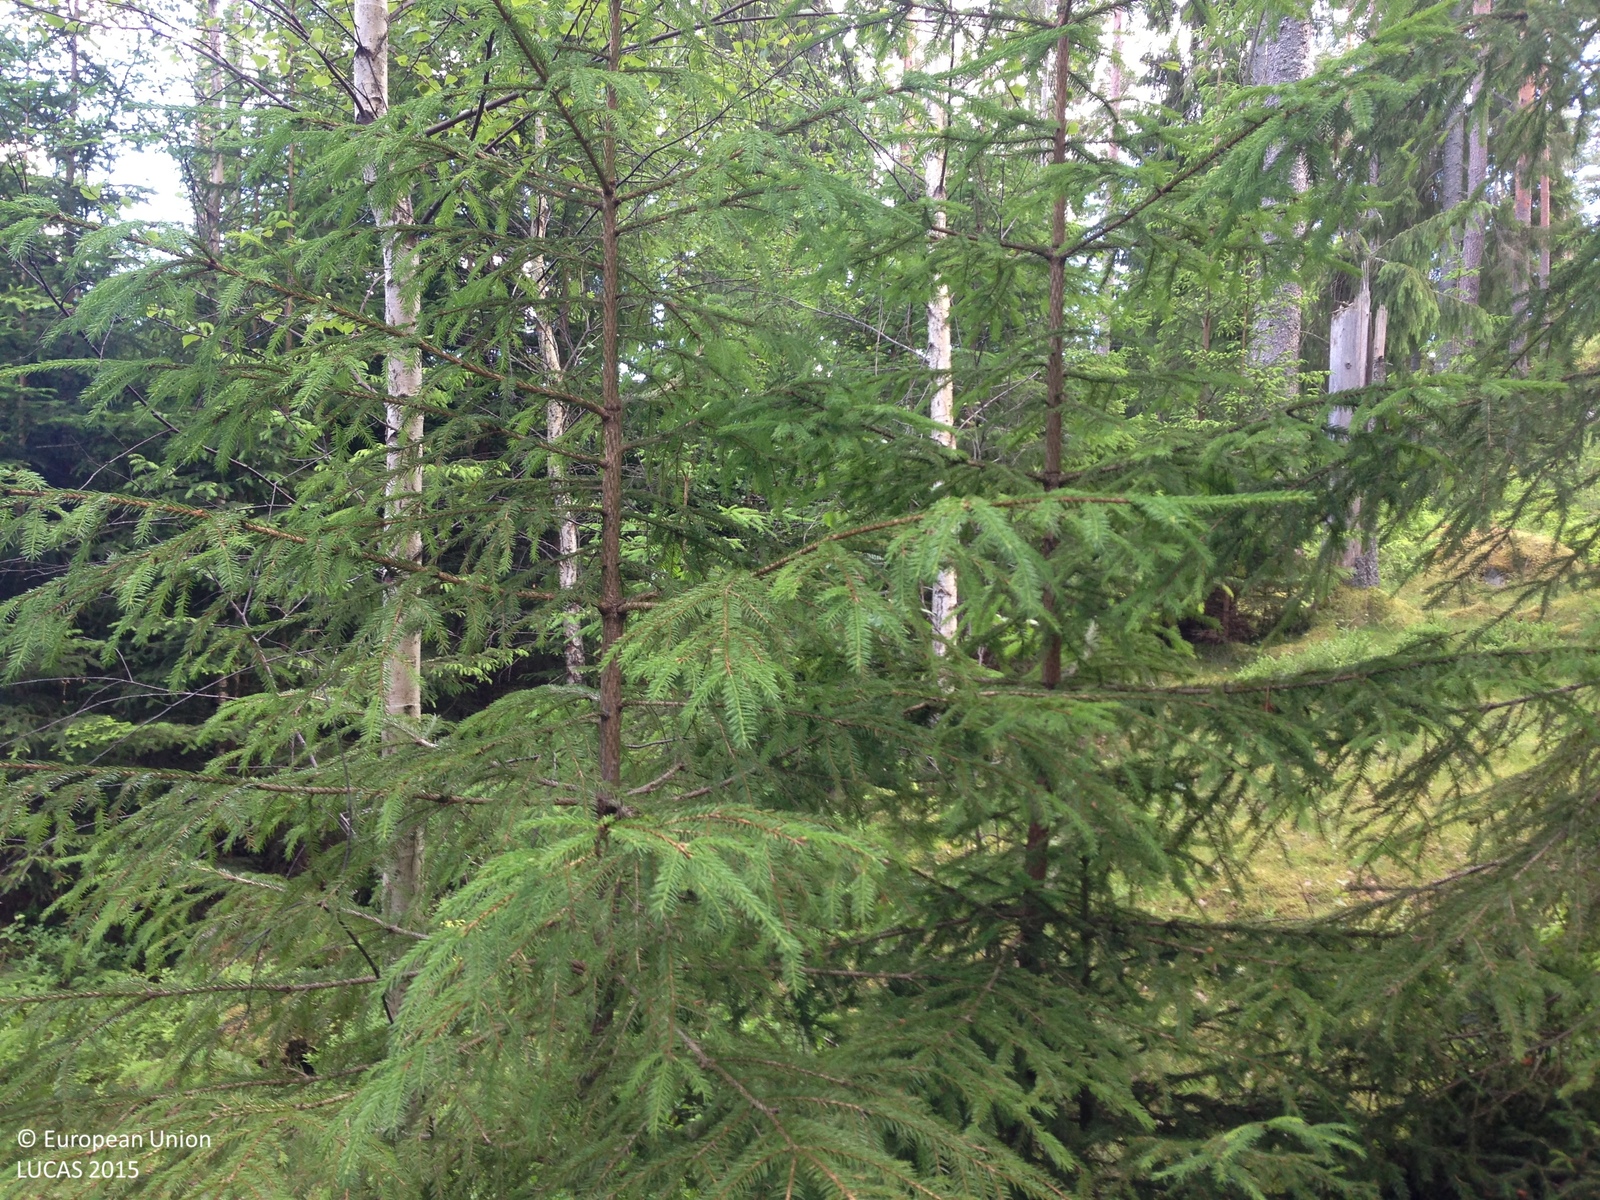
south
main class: Woodland
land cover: Spruce dominated coniferous woodland
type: boreal forest
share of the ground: 50 - 75 %
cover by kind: coniferous forest trees 60 %, shrubs 25 %, broadleaved forest trees 10 %, lichens and mosses 5 %
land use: Forestry
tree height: > 5 m
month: June
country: SE
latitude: 58.1246
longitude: 16.3298
